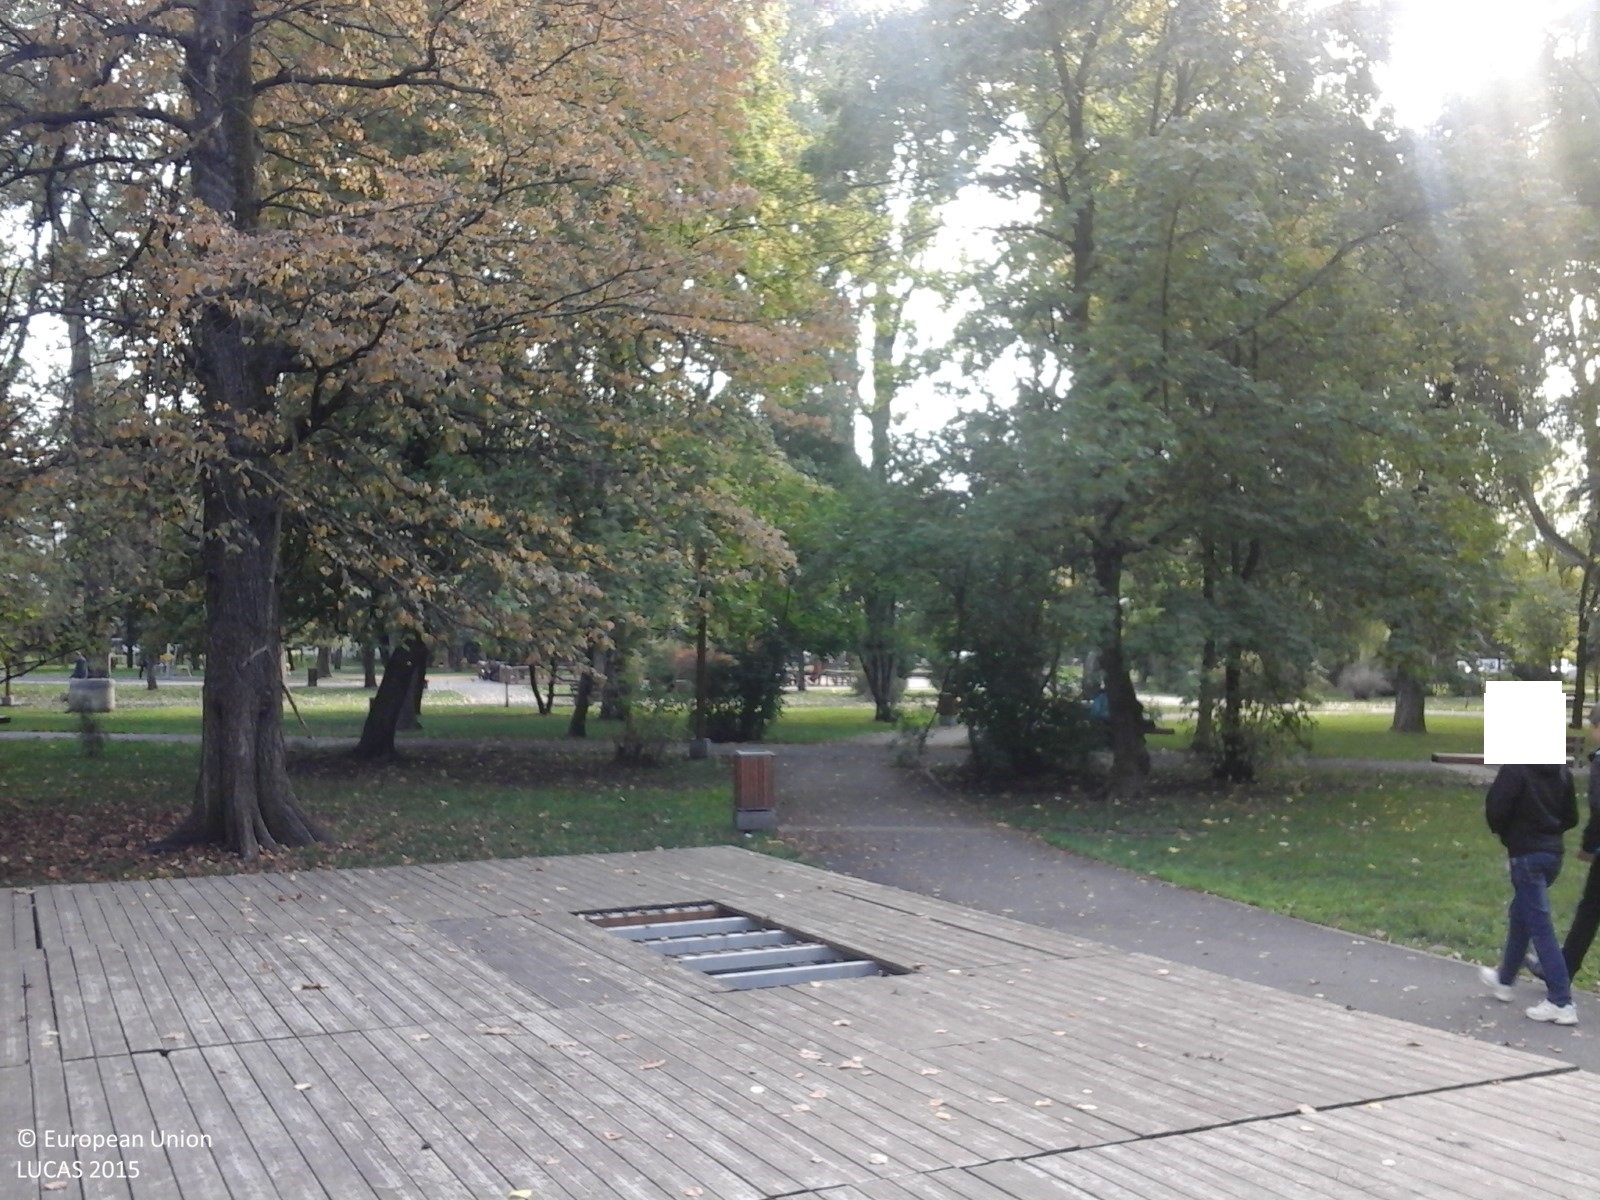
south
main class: Woodland
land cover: Broadleaved woodland
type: beech forest
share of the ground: > 75 %
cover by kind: broadleaved forest trees 80 %, herbaceous plants 20 %
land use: Amenities, museums, leisure
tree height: > 5 m
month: October
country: RO
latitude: 46.3592
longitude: 25.8021
